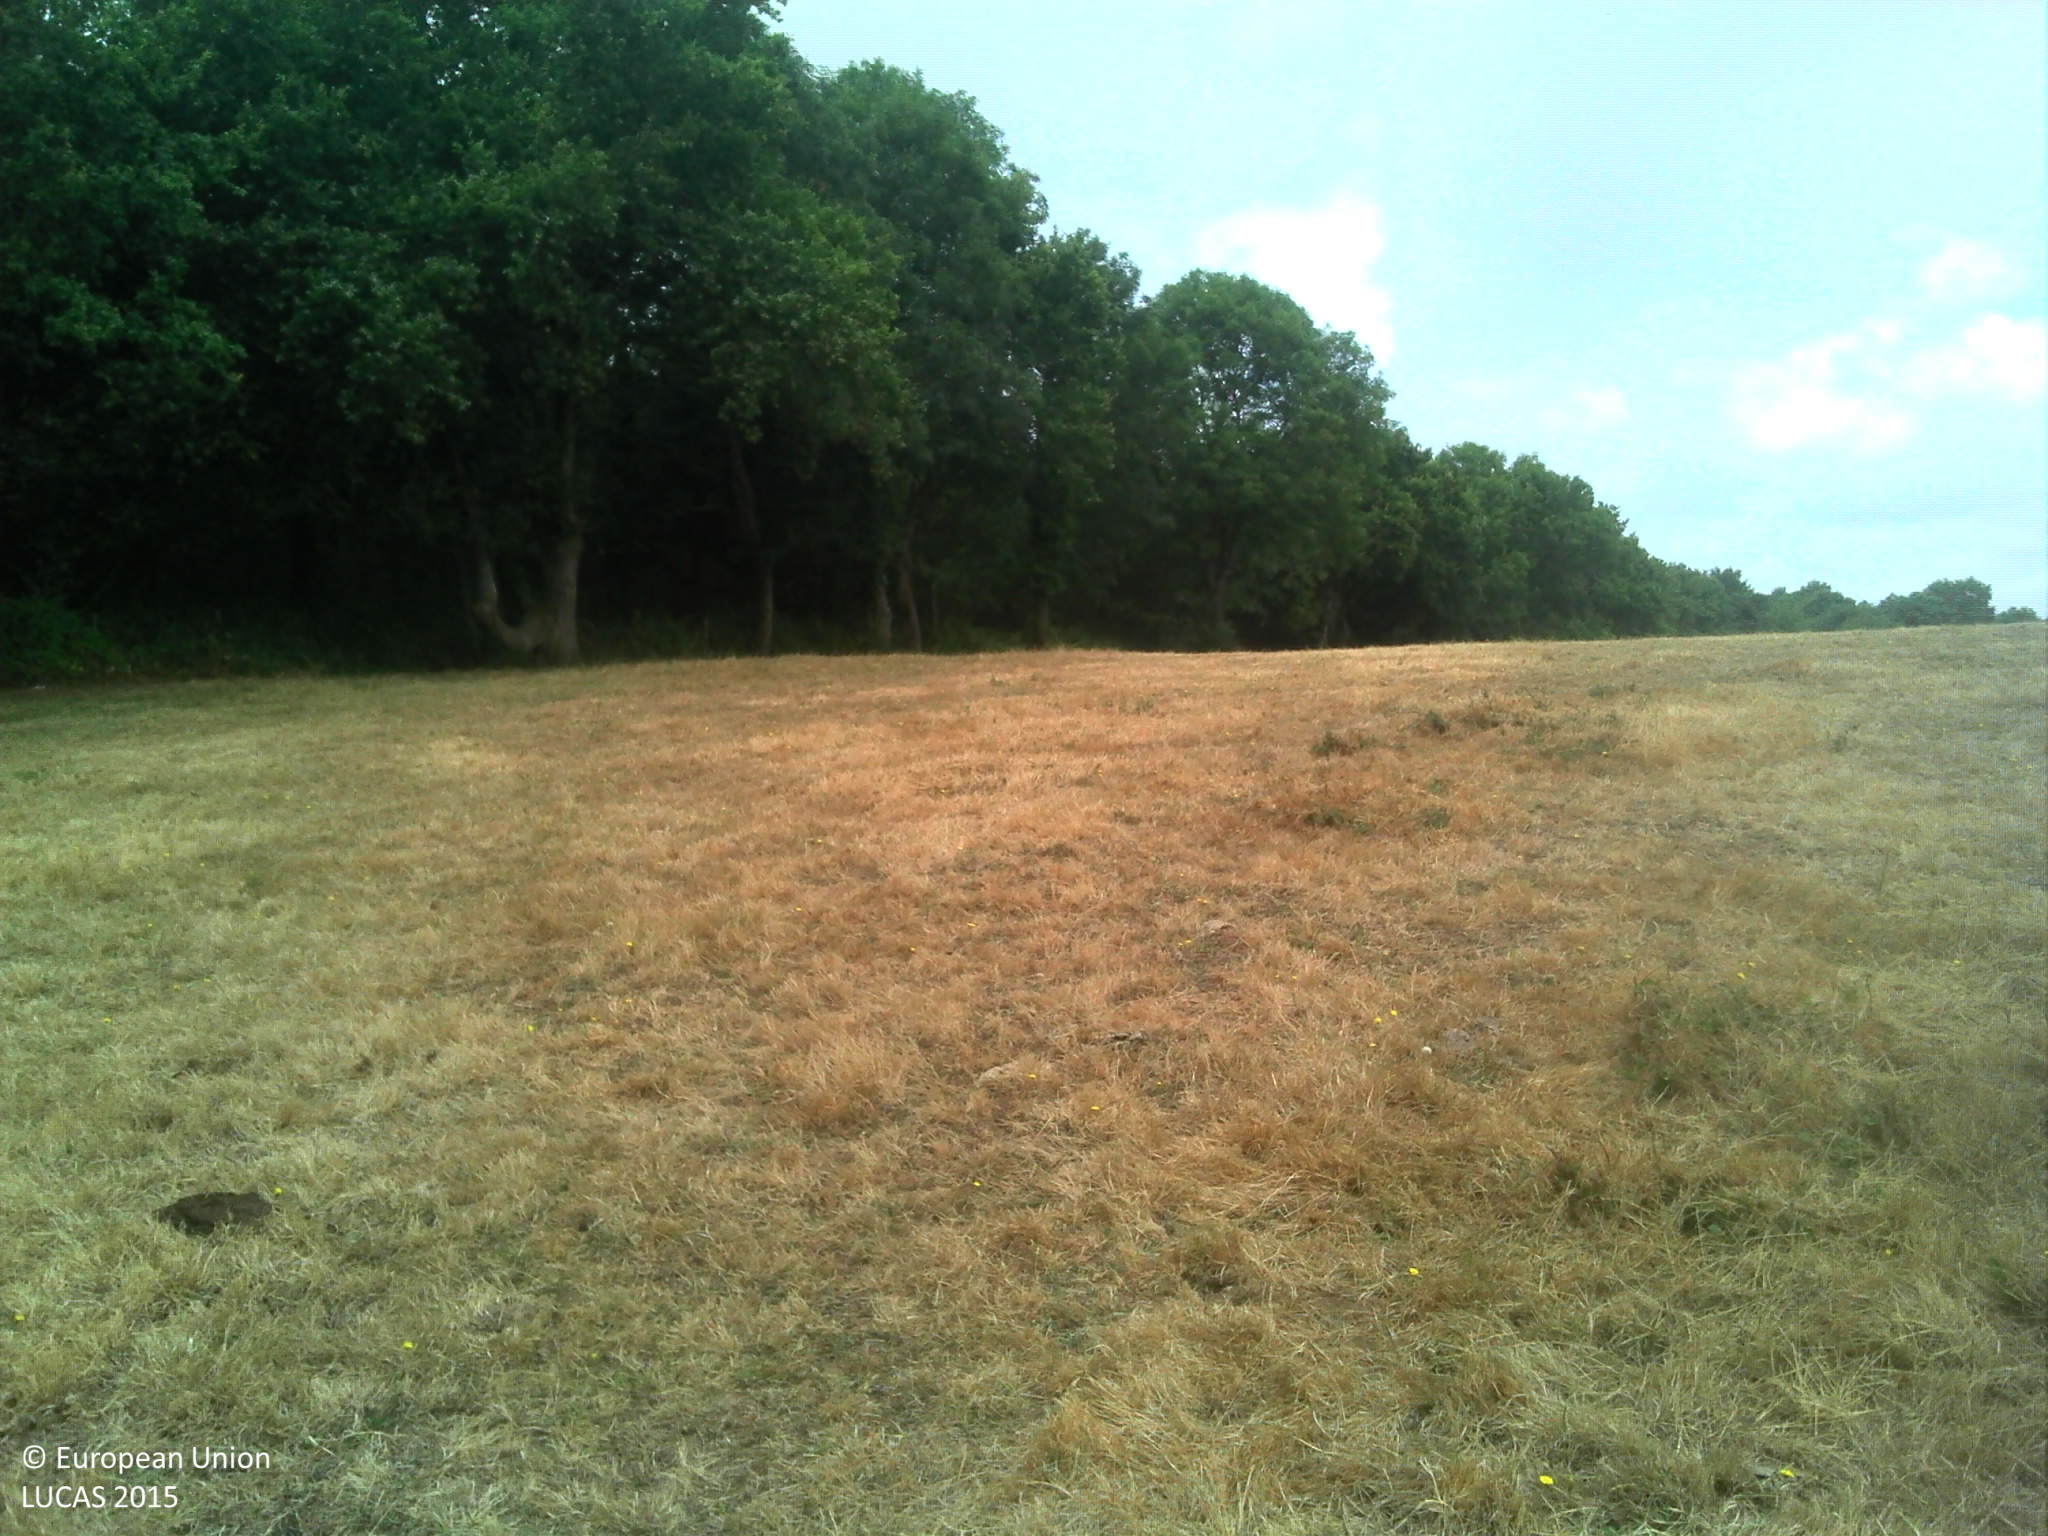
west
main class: Grassland
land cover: Grassland without tree/shrub cover
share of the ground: > 75 %
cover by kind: herbaceous plants 100 %
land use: Agriculture (excluding fallow land and kitchen gardens)
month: July
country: FR
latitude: 46.5224
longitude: -1.3906
